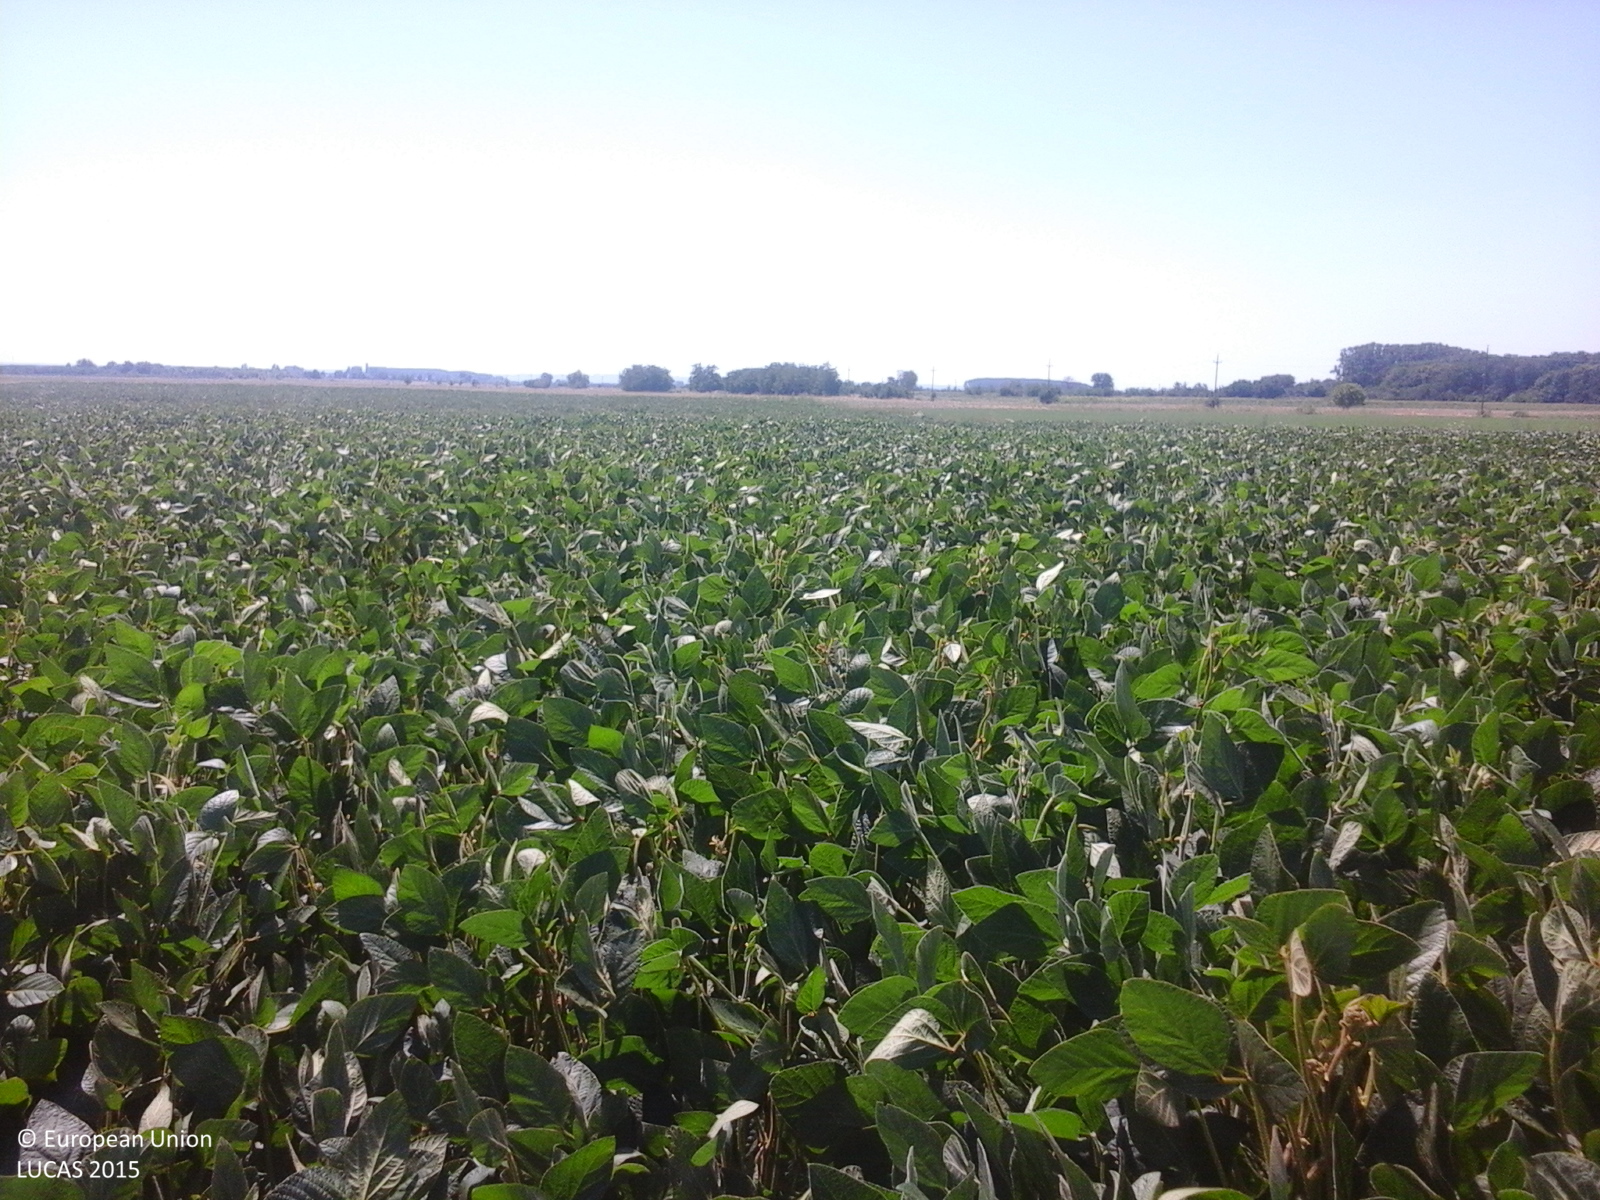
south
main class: Cropland
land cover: Soya
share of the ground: > 75 %
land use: Agriculture (excluding fallow land and kitchen gardens)
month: July
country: RO
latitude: 44.1805
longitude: 26.5887
